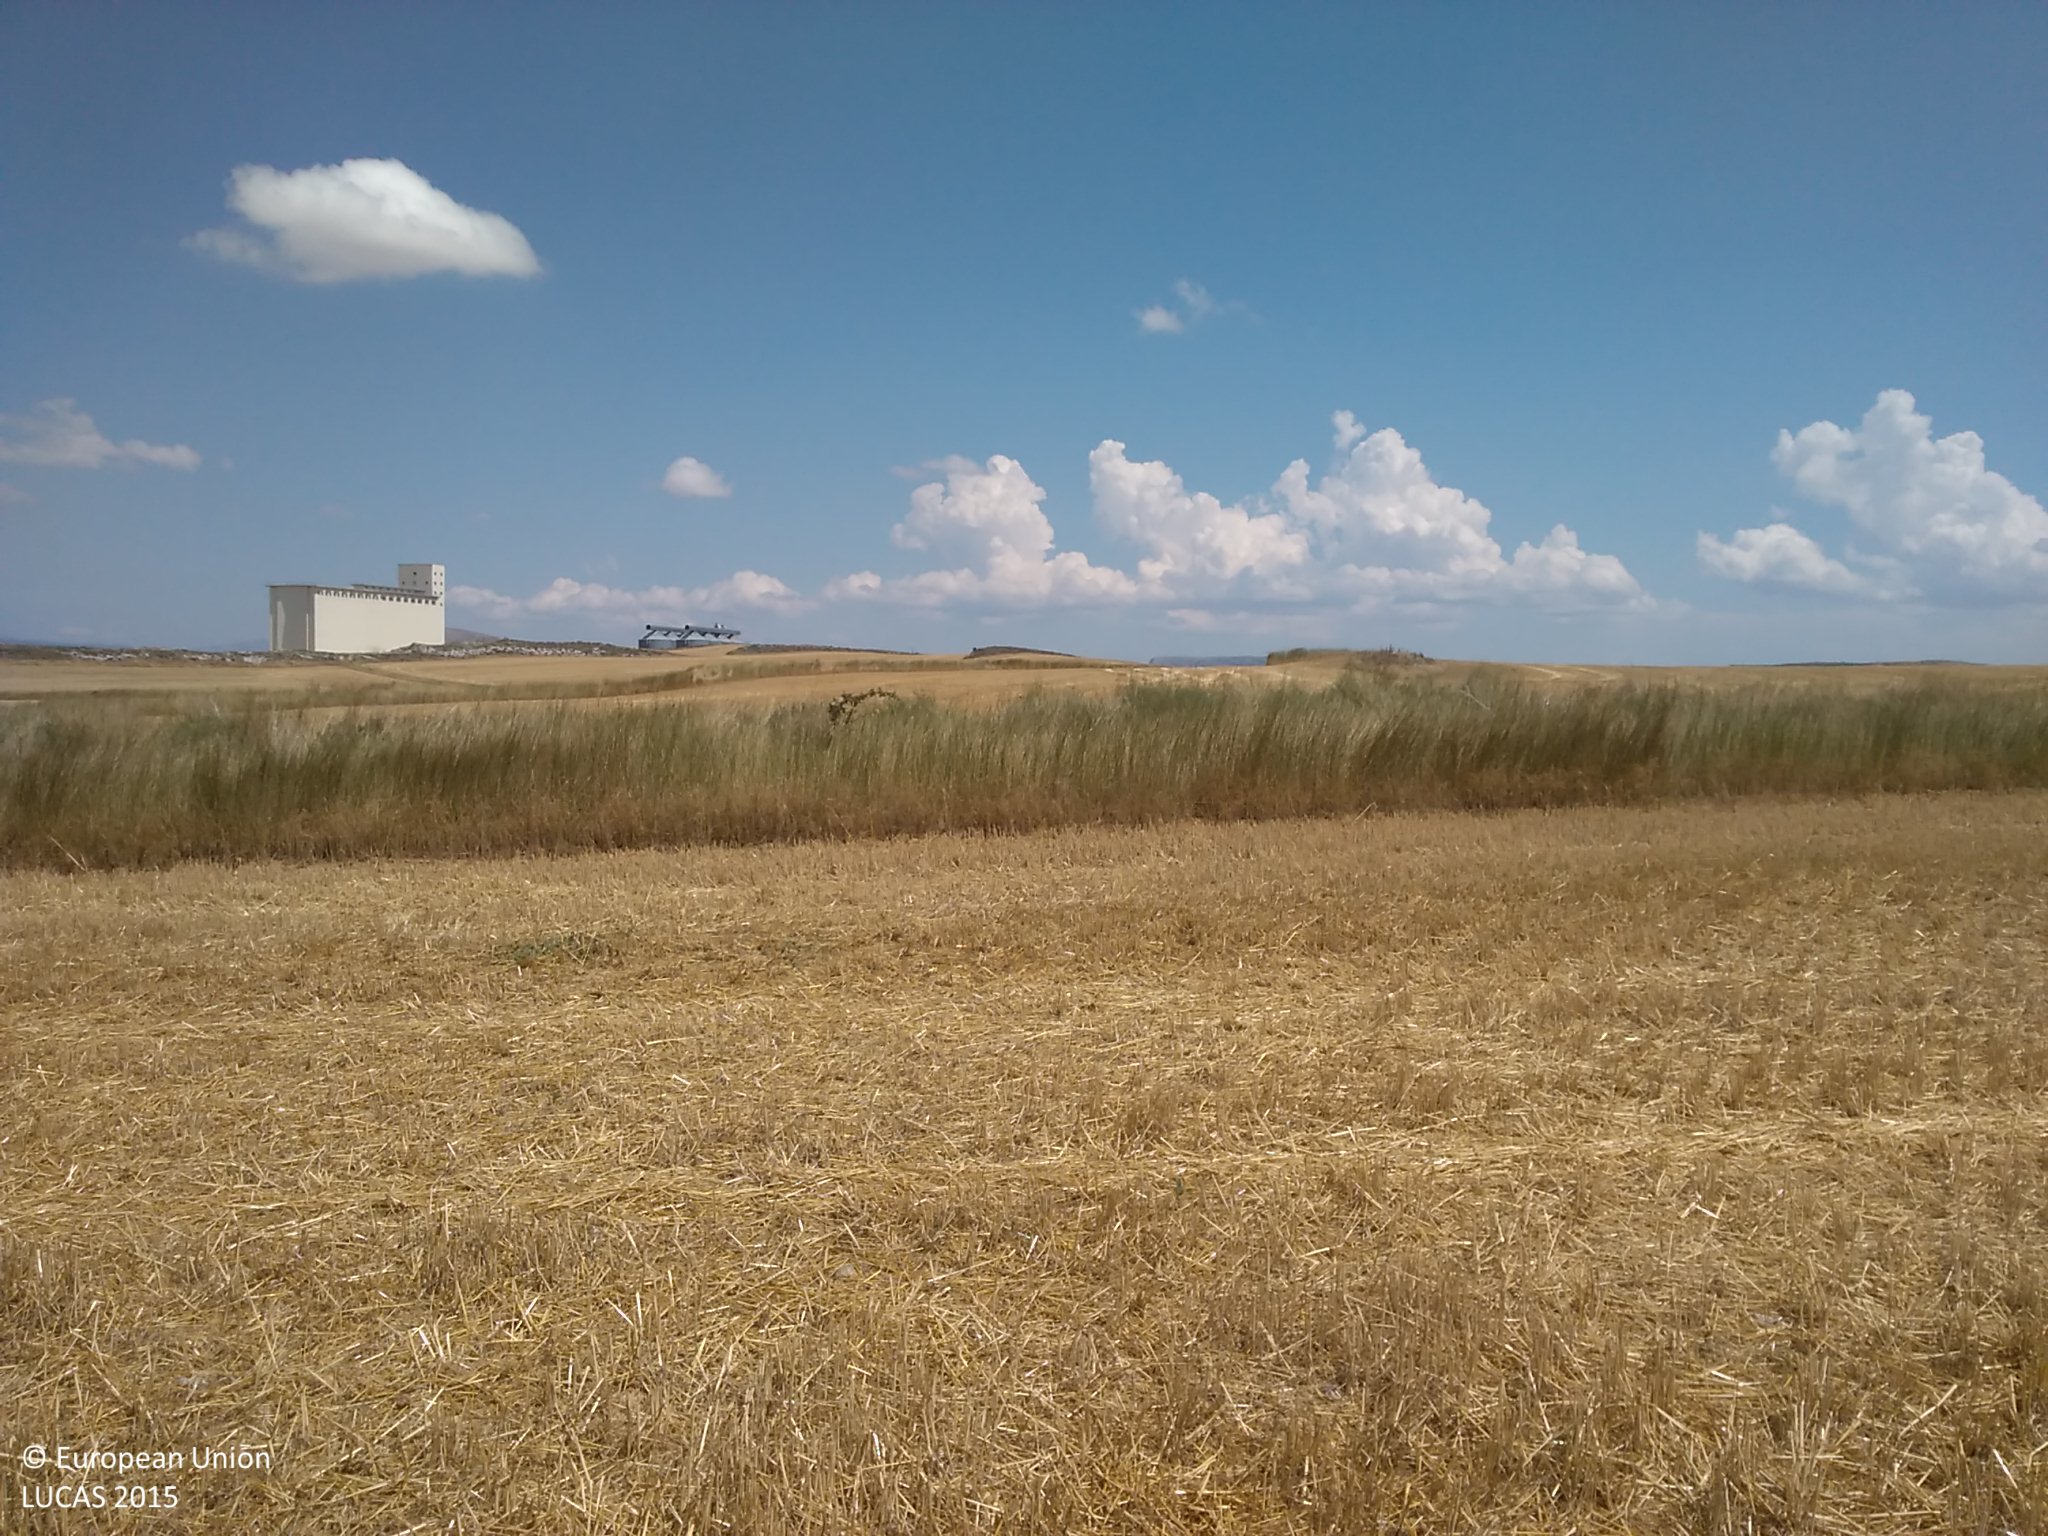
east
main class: Cropland
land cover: Common wheat
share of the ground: < 10 %
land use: Agriculture (excluding fallow land and kitchen gardens)
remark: Harvested field
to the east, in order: Common wheat; Grassland without tree/shrub cover; Rivers and streams; Grassland without tree/shrub cover; Common wheat; Grassland without tree/shrub cover; Common wheat
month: July
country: ES
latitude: 41.6553
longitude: -2.2224
